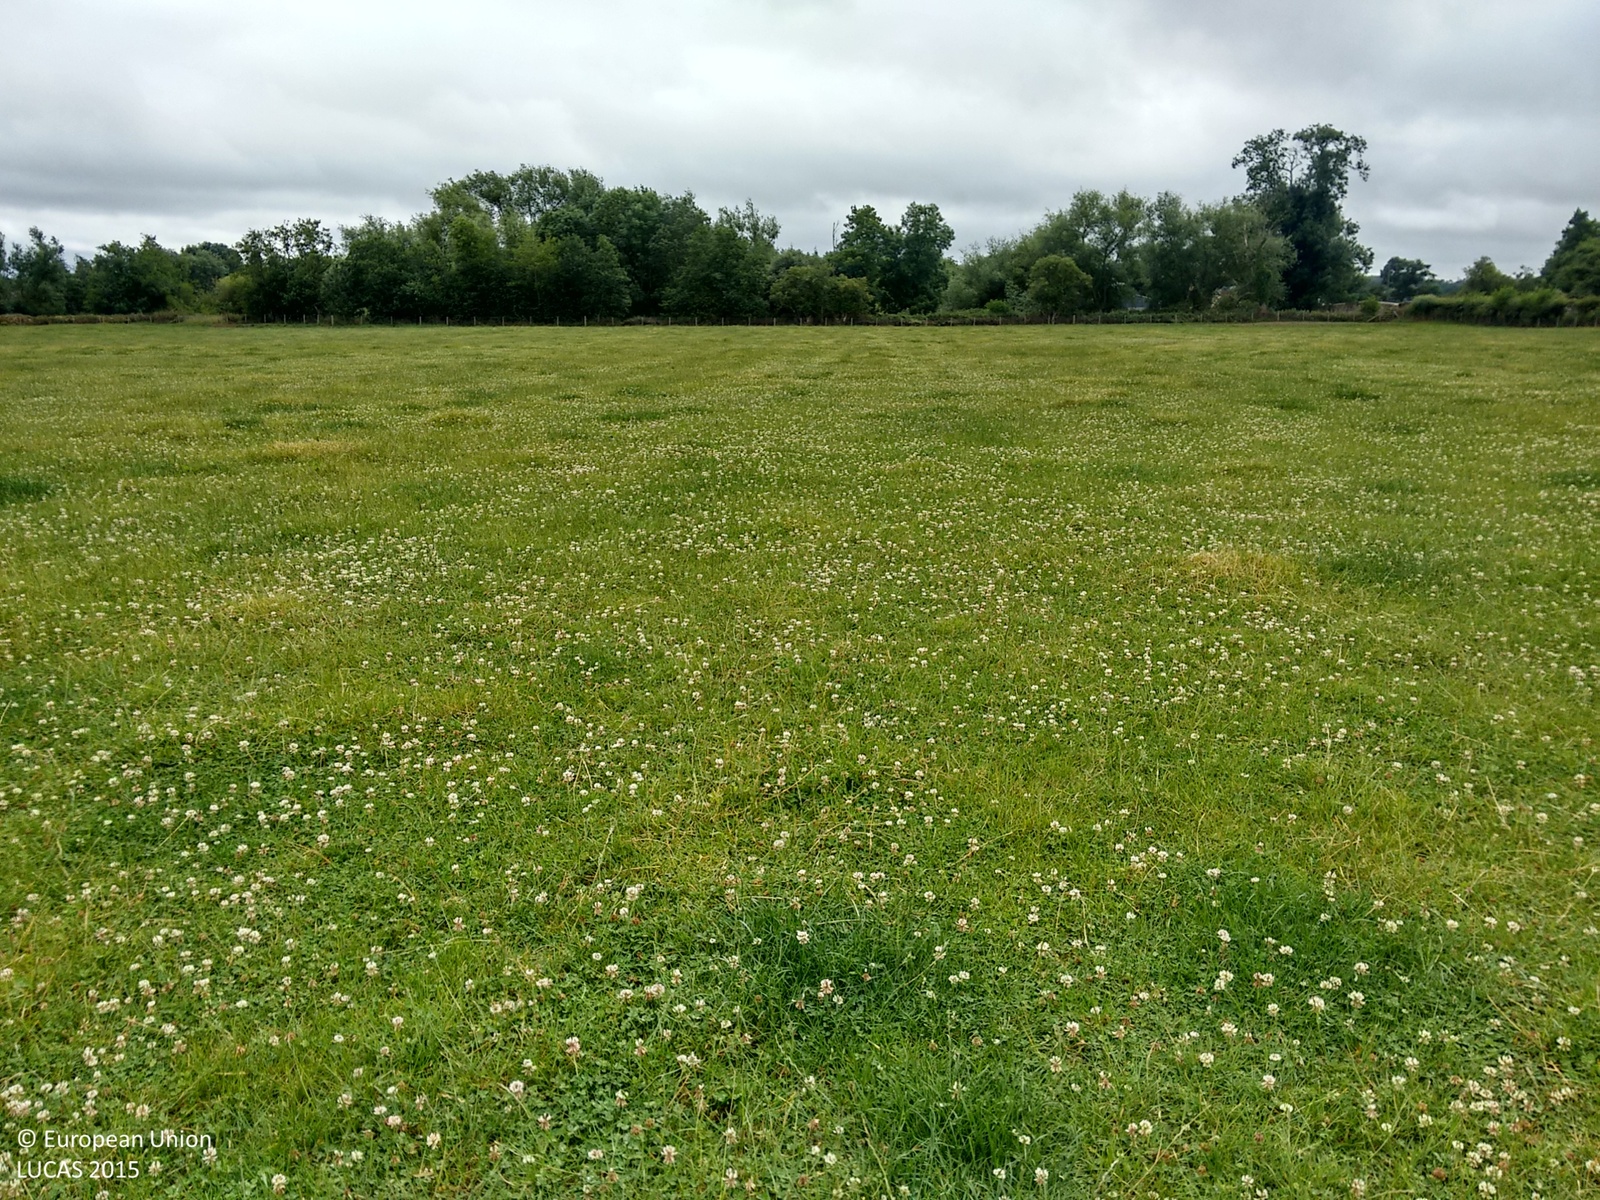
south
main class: Grassland
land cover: Grassland without tree/shrub cover
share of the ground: > 75 %
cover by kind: herbaceous plants 100 %
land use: Agriculture (excluding fallow land and kitchen gardens)
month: July
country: GB
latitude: 52.2248
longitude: -2.8228
